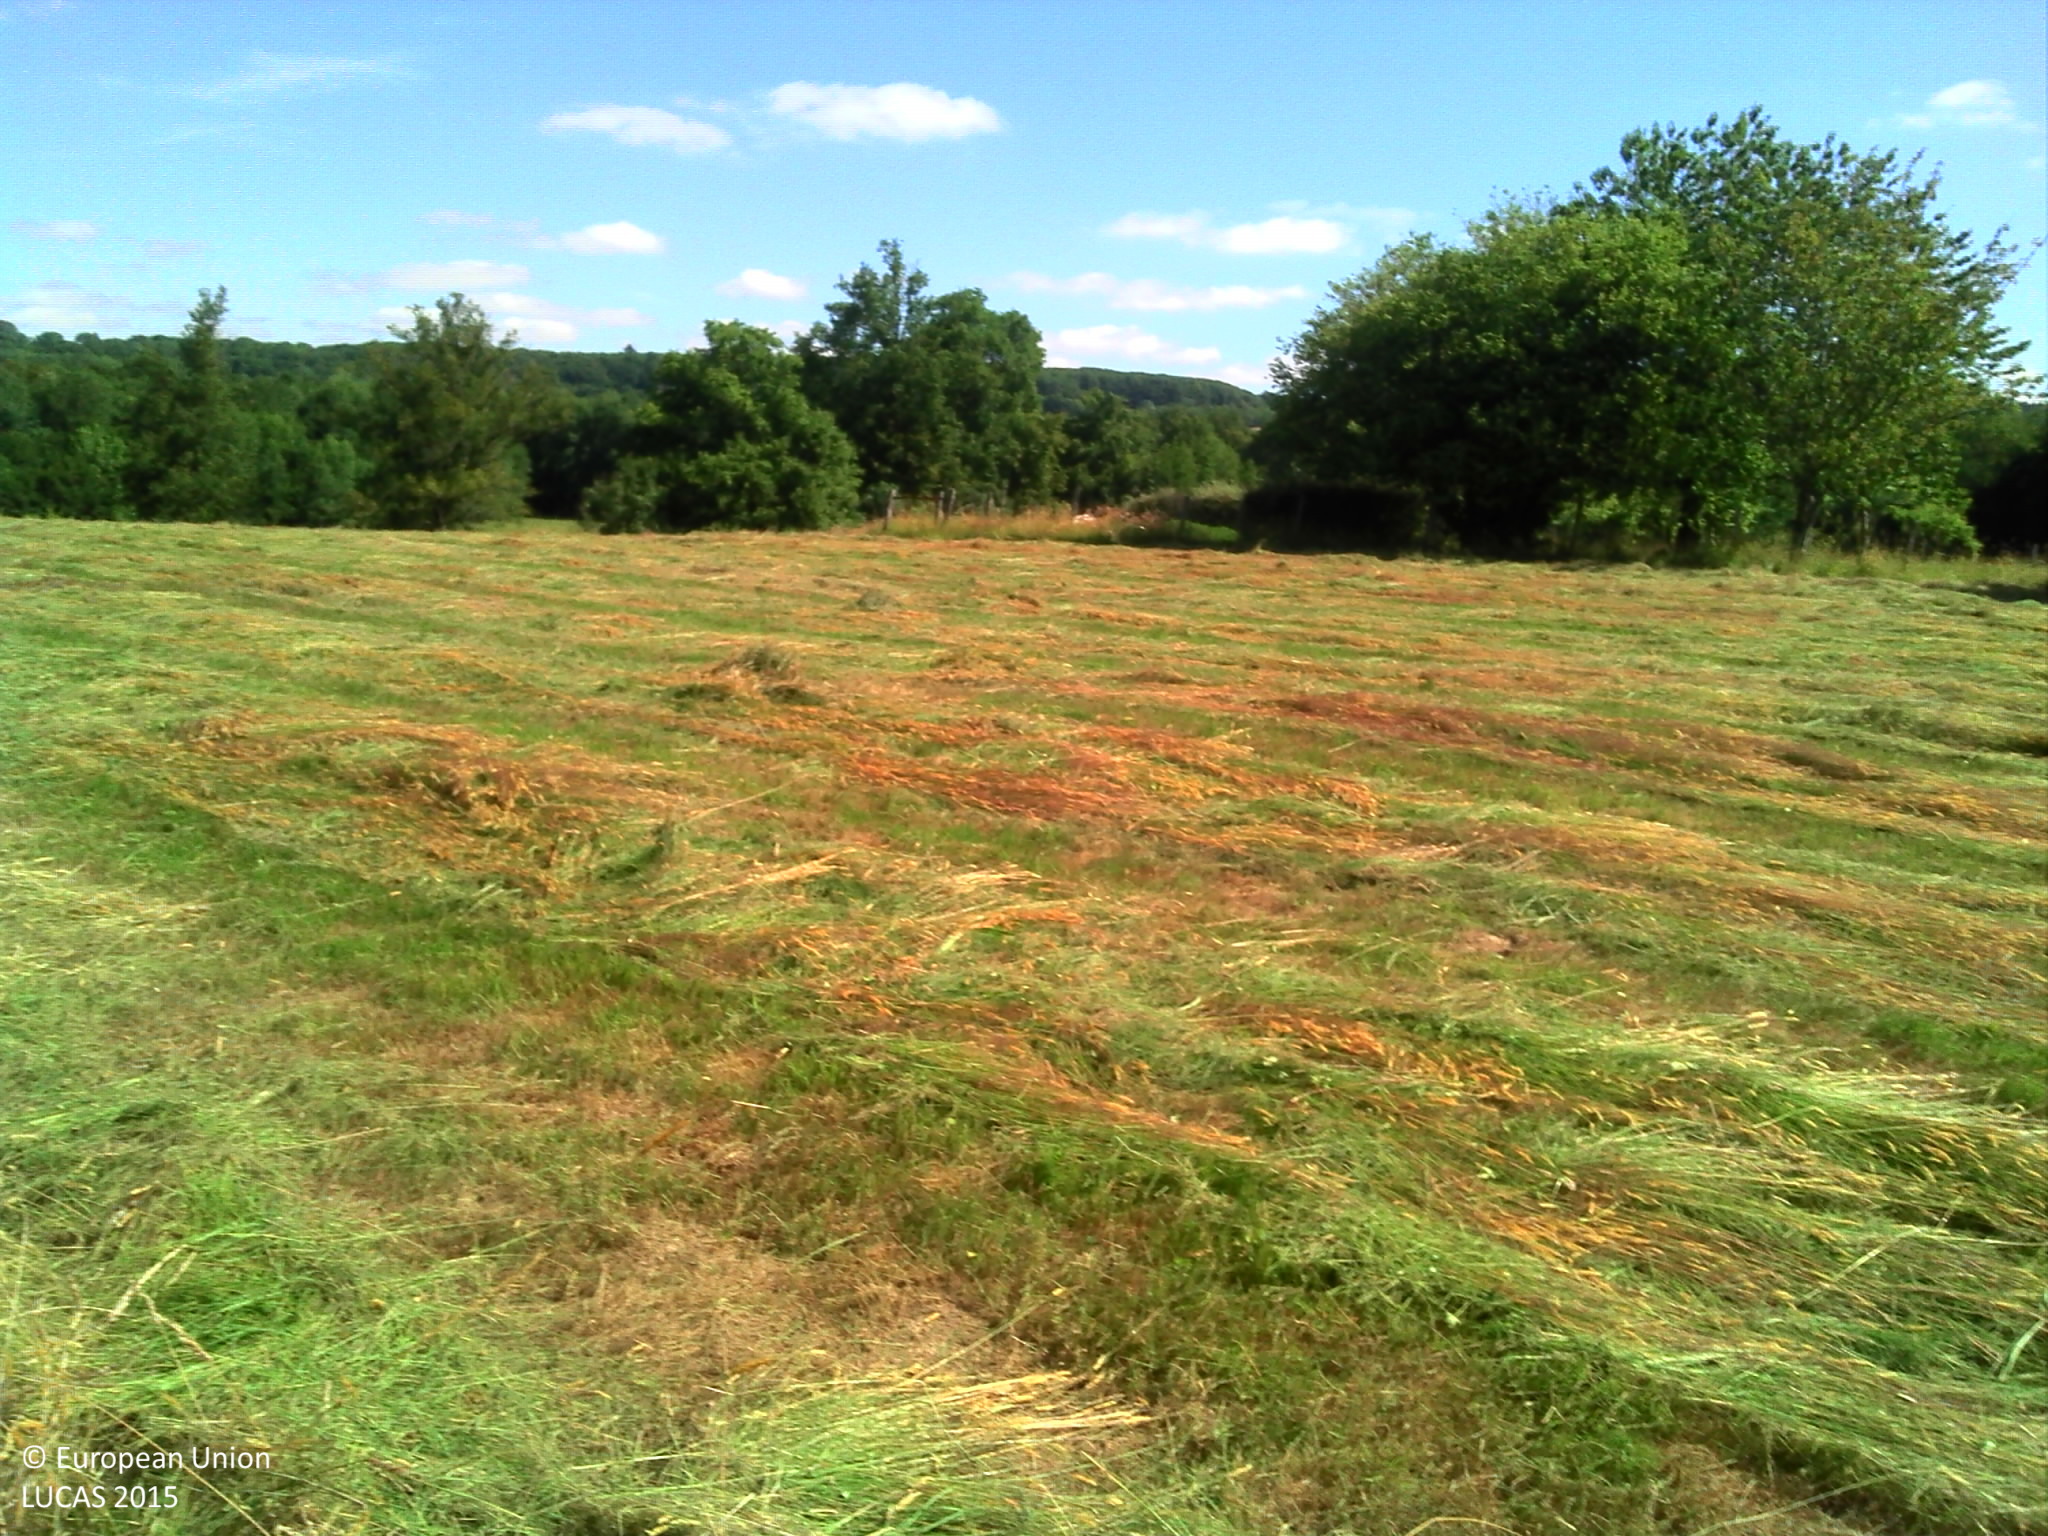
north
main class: Grassland
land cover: Grassland without tree/shrub cover
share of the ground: > 75 %
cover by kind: herbaceous plants 100 %
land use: Agriculture (excluding fallow land and kitchen gardens)
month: June
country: FR
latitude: 47.2684
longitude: 2.5781
